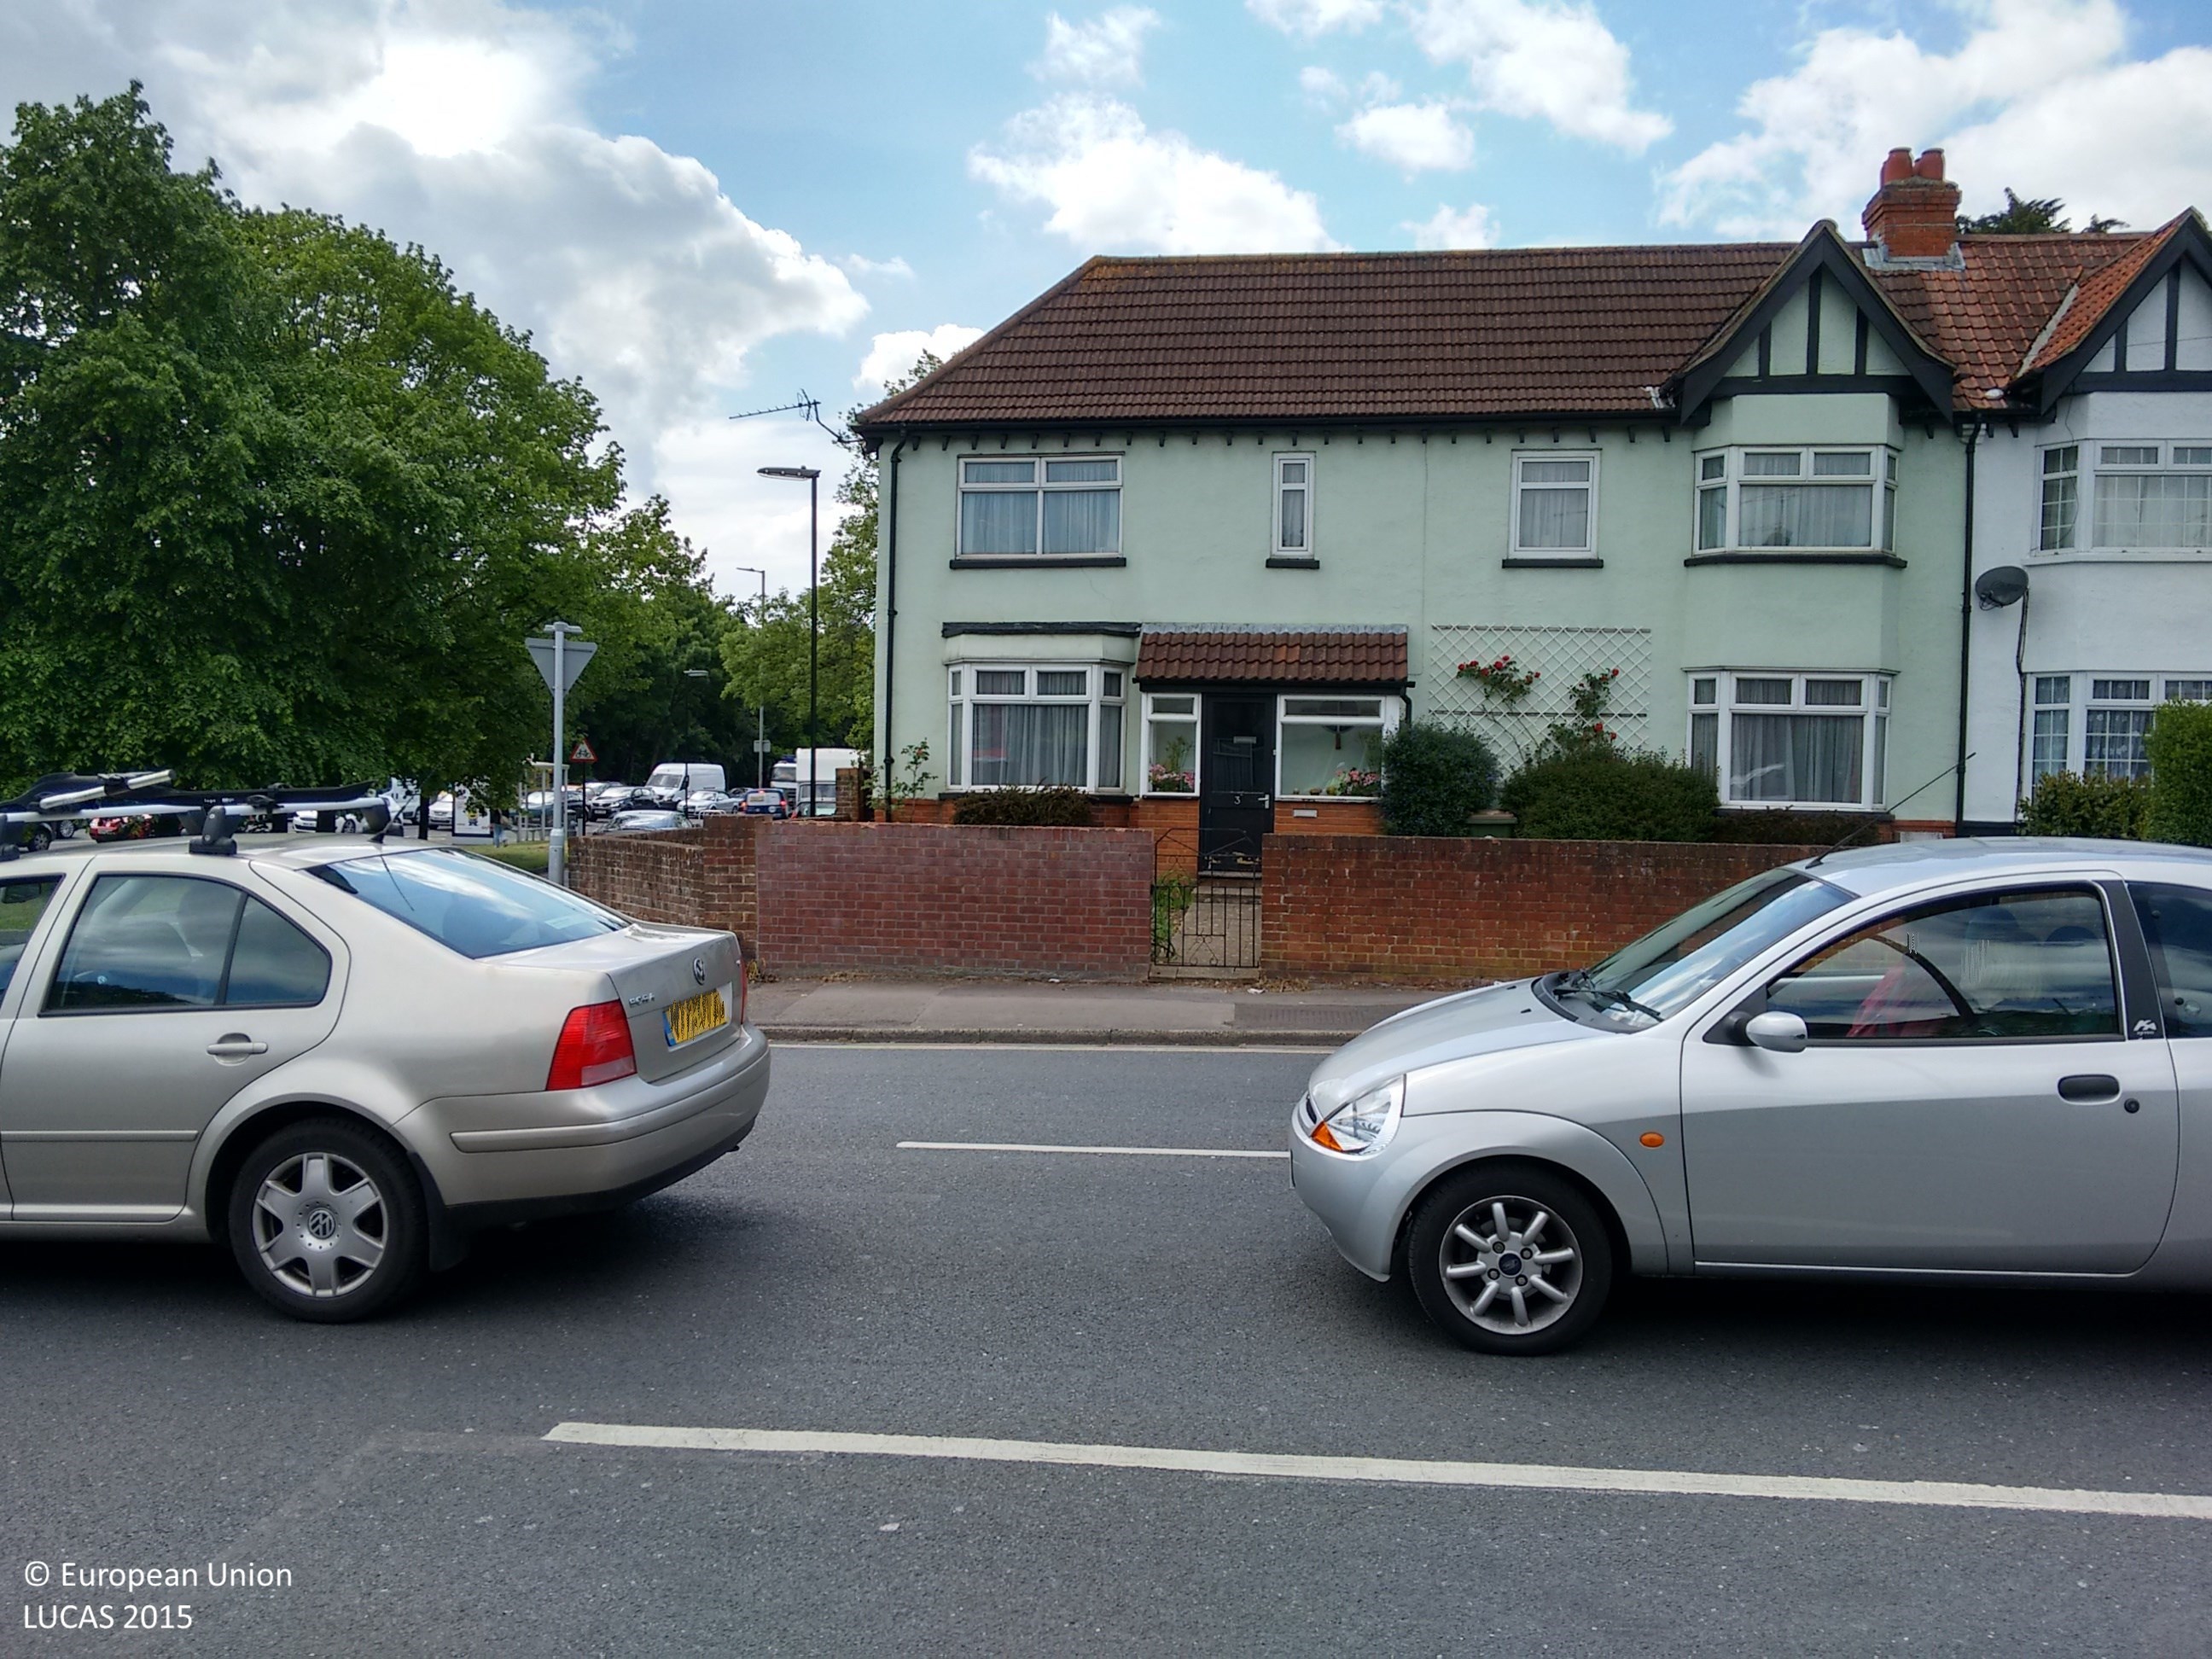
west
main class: Grassland
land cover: Grassland without tree/shrub cover
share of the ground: 50 - 75 %
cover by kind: herbaceous plants 95 %, shrubs 5 %
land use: Residential
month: May
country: GB
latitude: 50.9138
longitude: -1.4431
